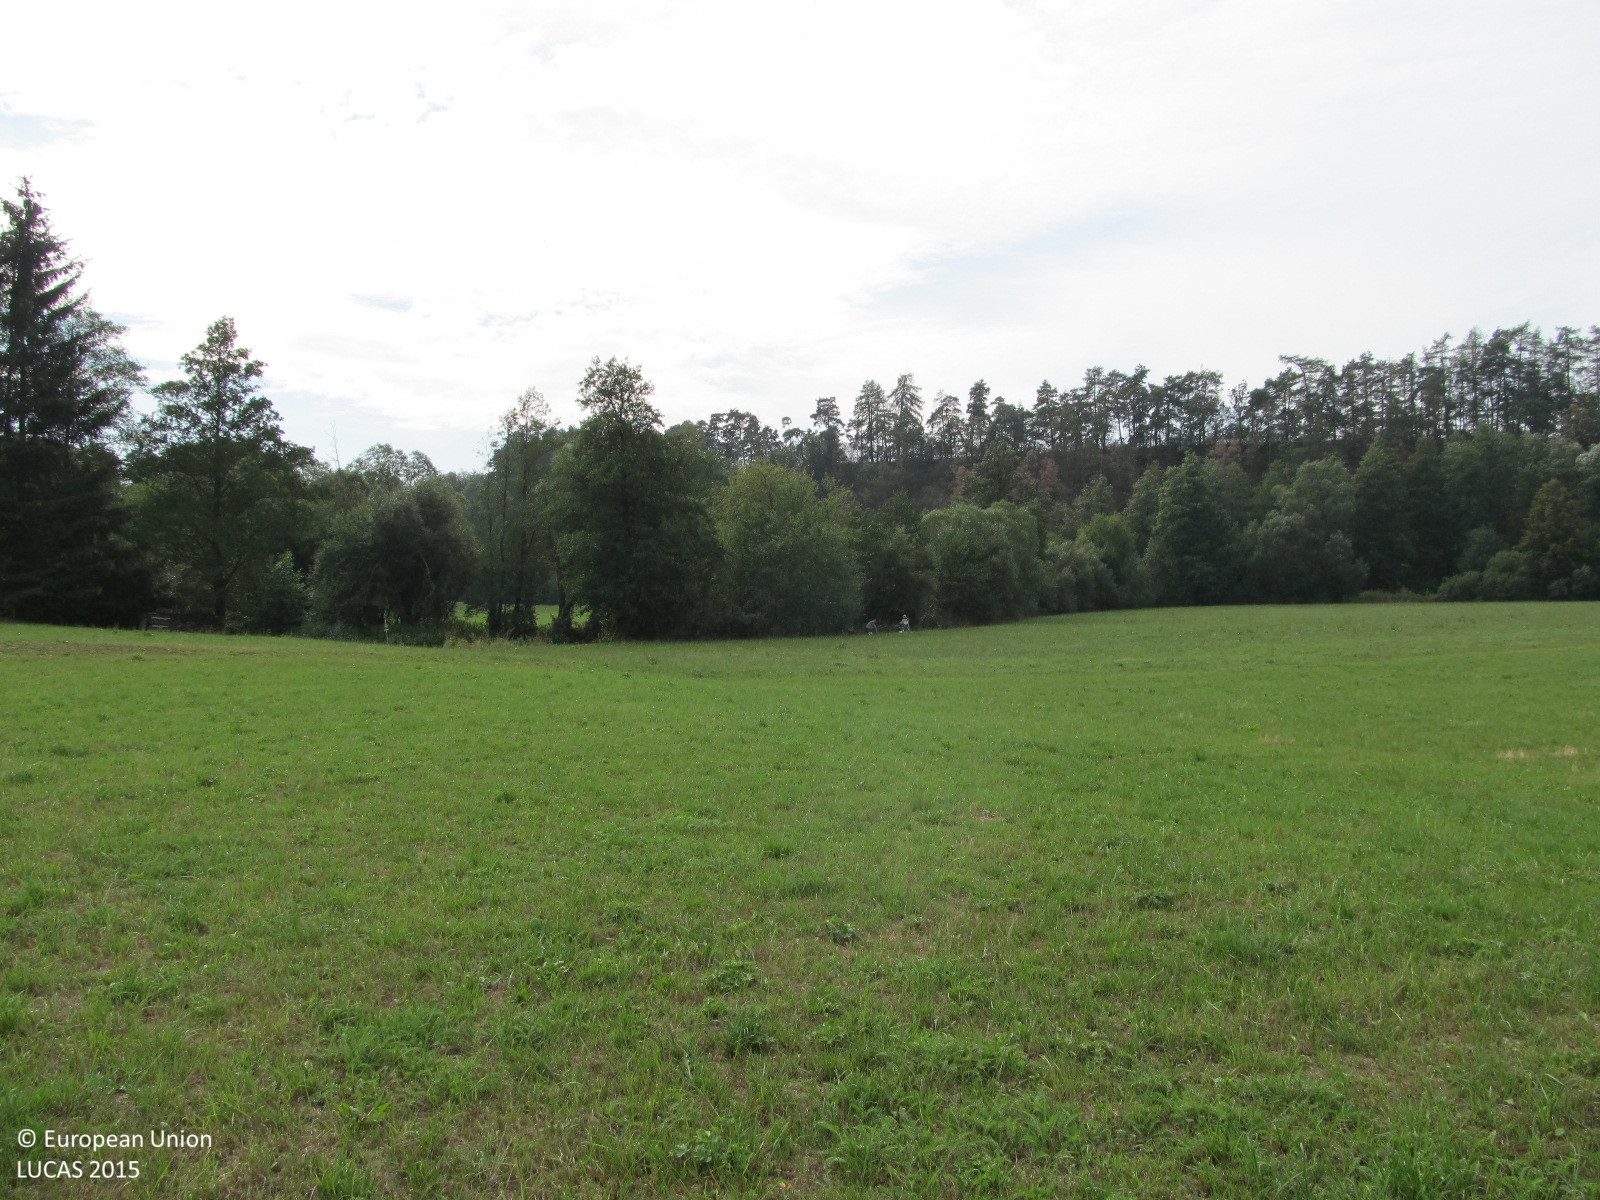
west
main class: Grassland
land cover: Grassland without tree/shrub cover
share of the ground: > 75 %
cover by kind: herbaceous plants 100 %
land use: Agriculture (excluding fallow land and kitchen gardens)
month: August
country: AT
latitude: 48.9170
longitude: 15.4753
